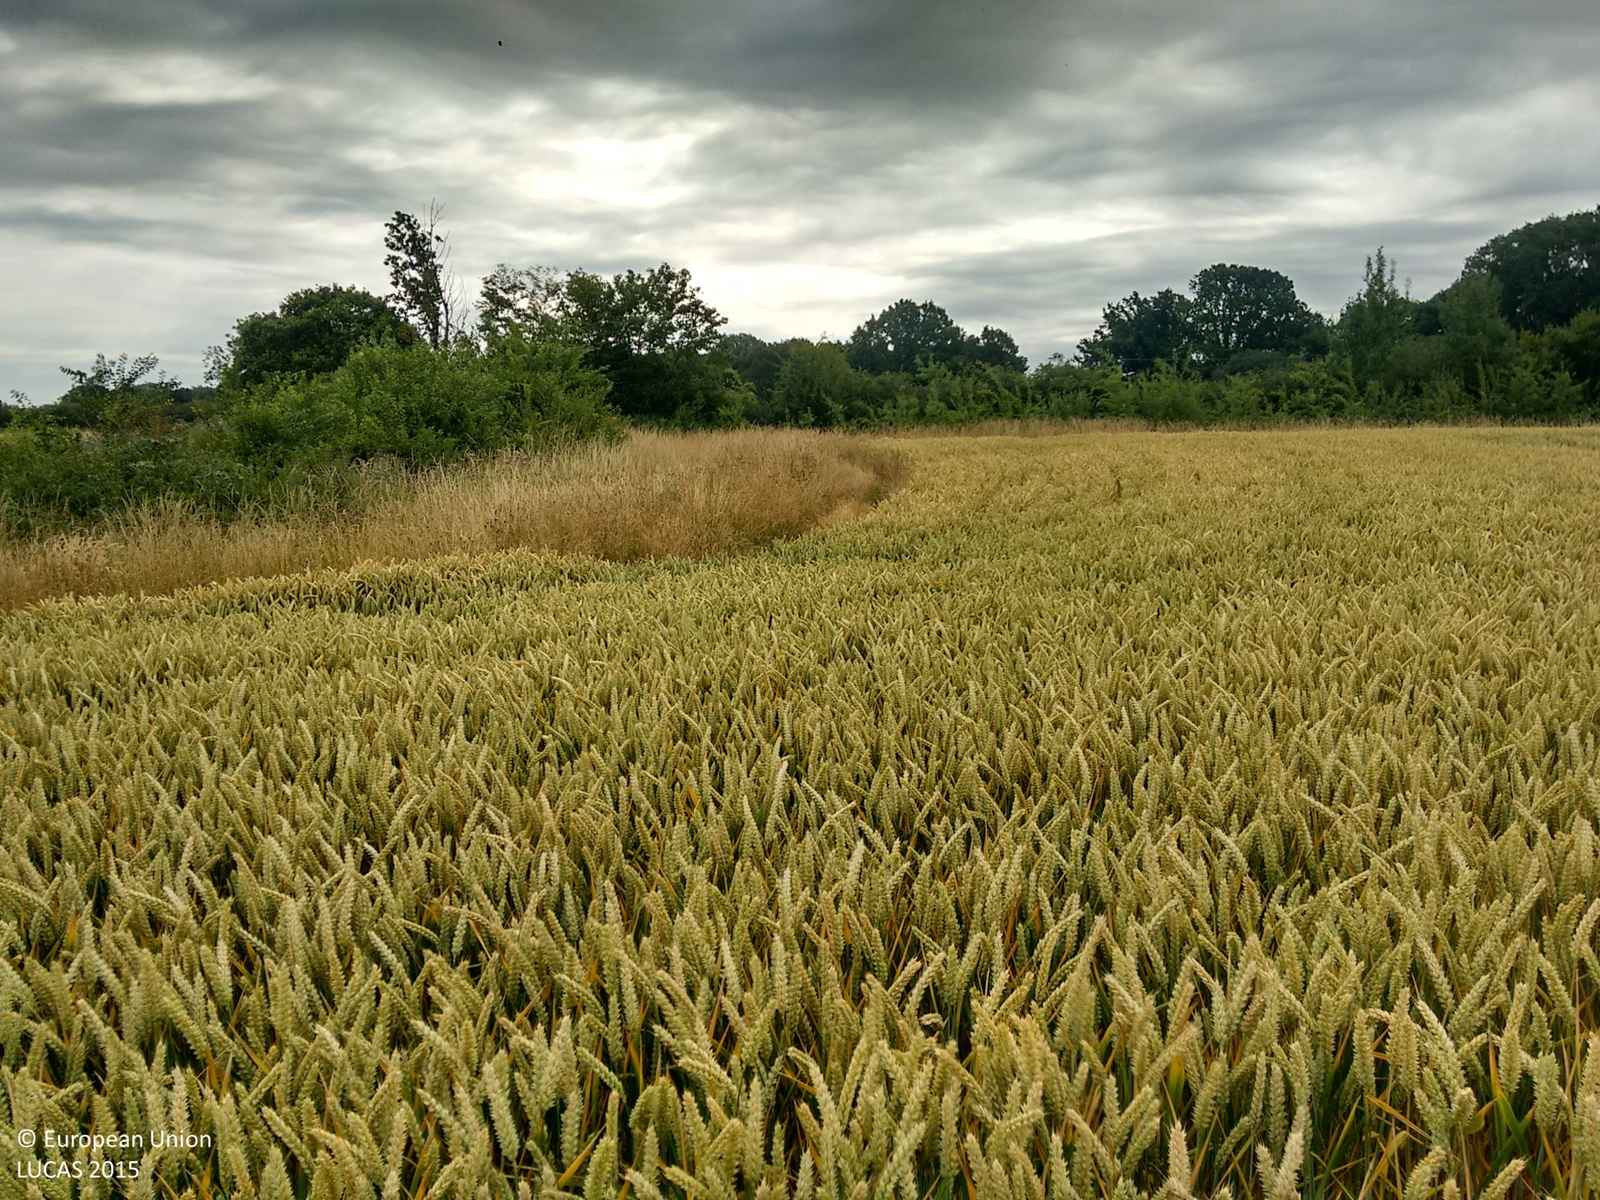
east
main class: Cropland
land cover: Common wheat
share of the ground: > 75 %
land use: Agriculture (excluding fallow land and kitchen gardens)
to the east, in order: Common wheat; Grassland without tree/shrub cover; Ditches and canals; Abandoned hedges; Grass margins; Common wheat; Grass margins; Abandoned hedges; Ditches and canals; Grass margins; Electric lines; Paved roads, cycling and walking lanes; Electric lines; Managed hedges; Fences; Grassland without tree/shrub cover
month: July
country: GB
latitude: 51.6854
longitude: 0.4687
